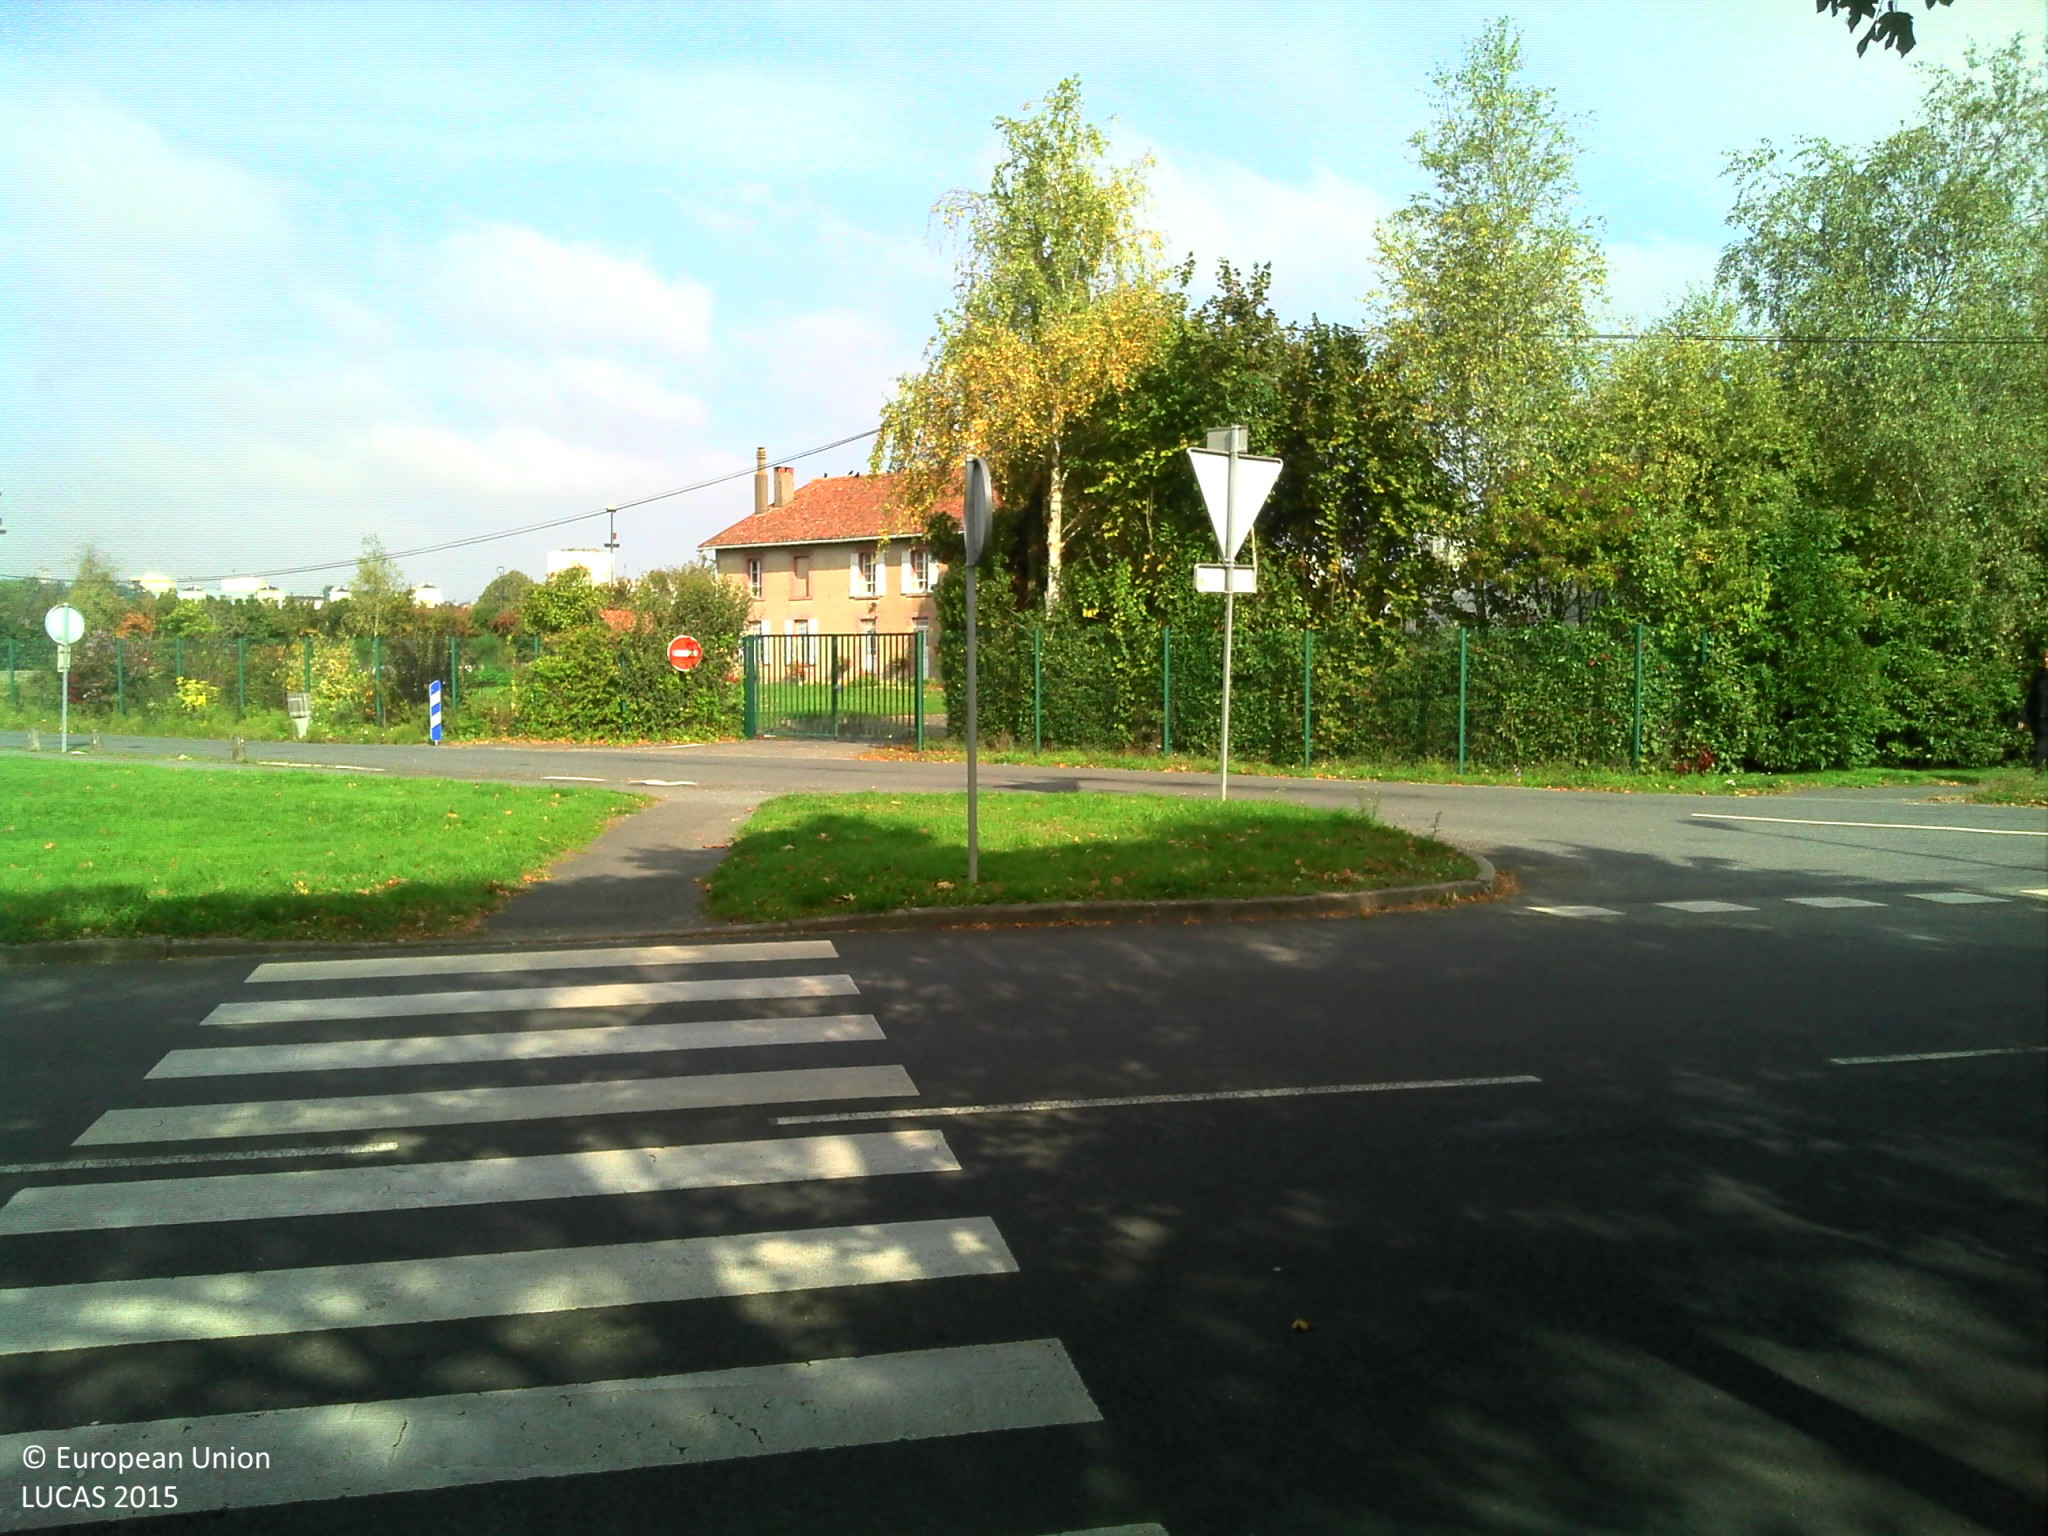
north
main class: Woodland
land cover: Broadleaved woodland
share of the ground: > 75 %
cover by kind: broadleaved forest trees 80 %, herbaceous plants 20 %
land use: Amenities, museums, leisure
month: October
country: FR
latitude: 47.0492
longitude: -0.8663
